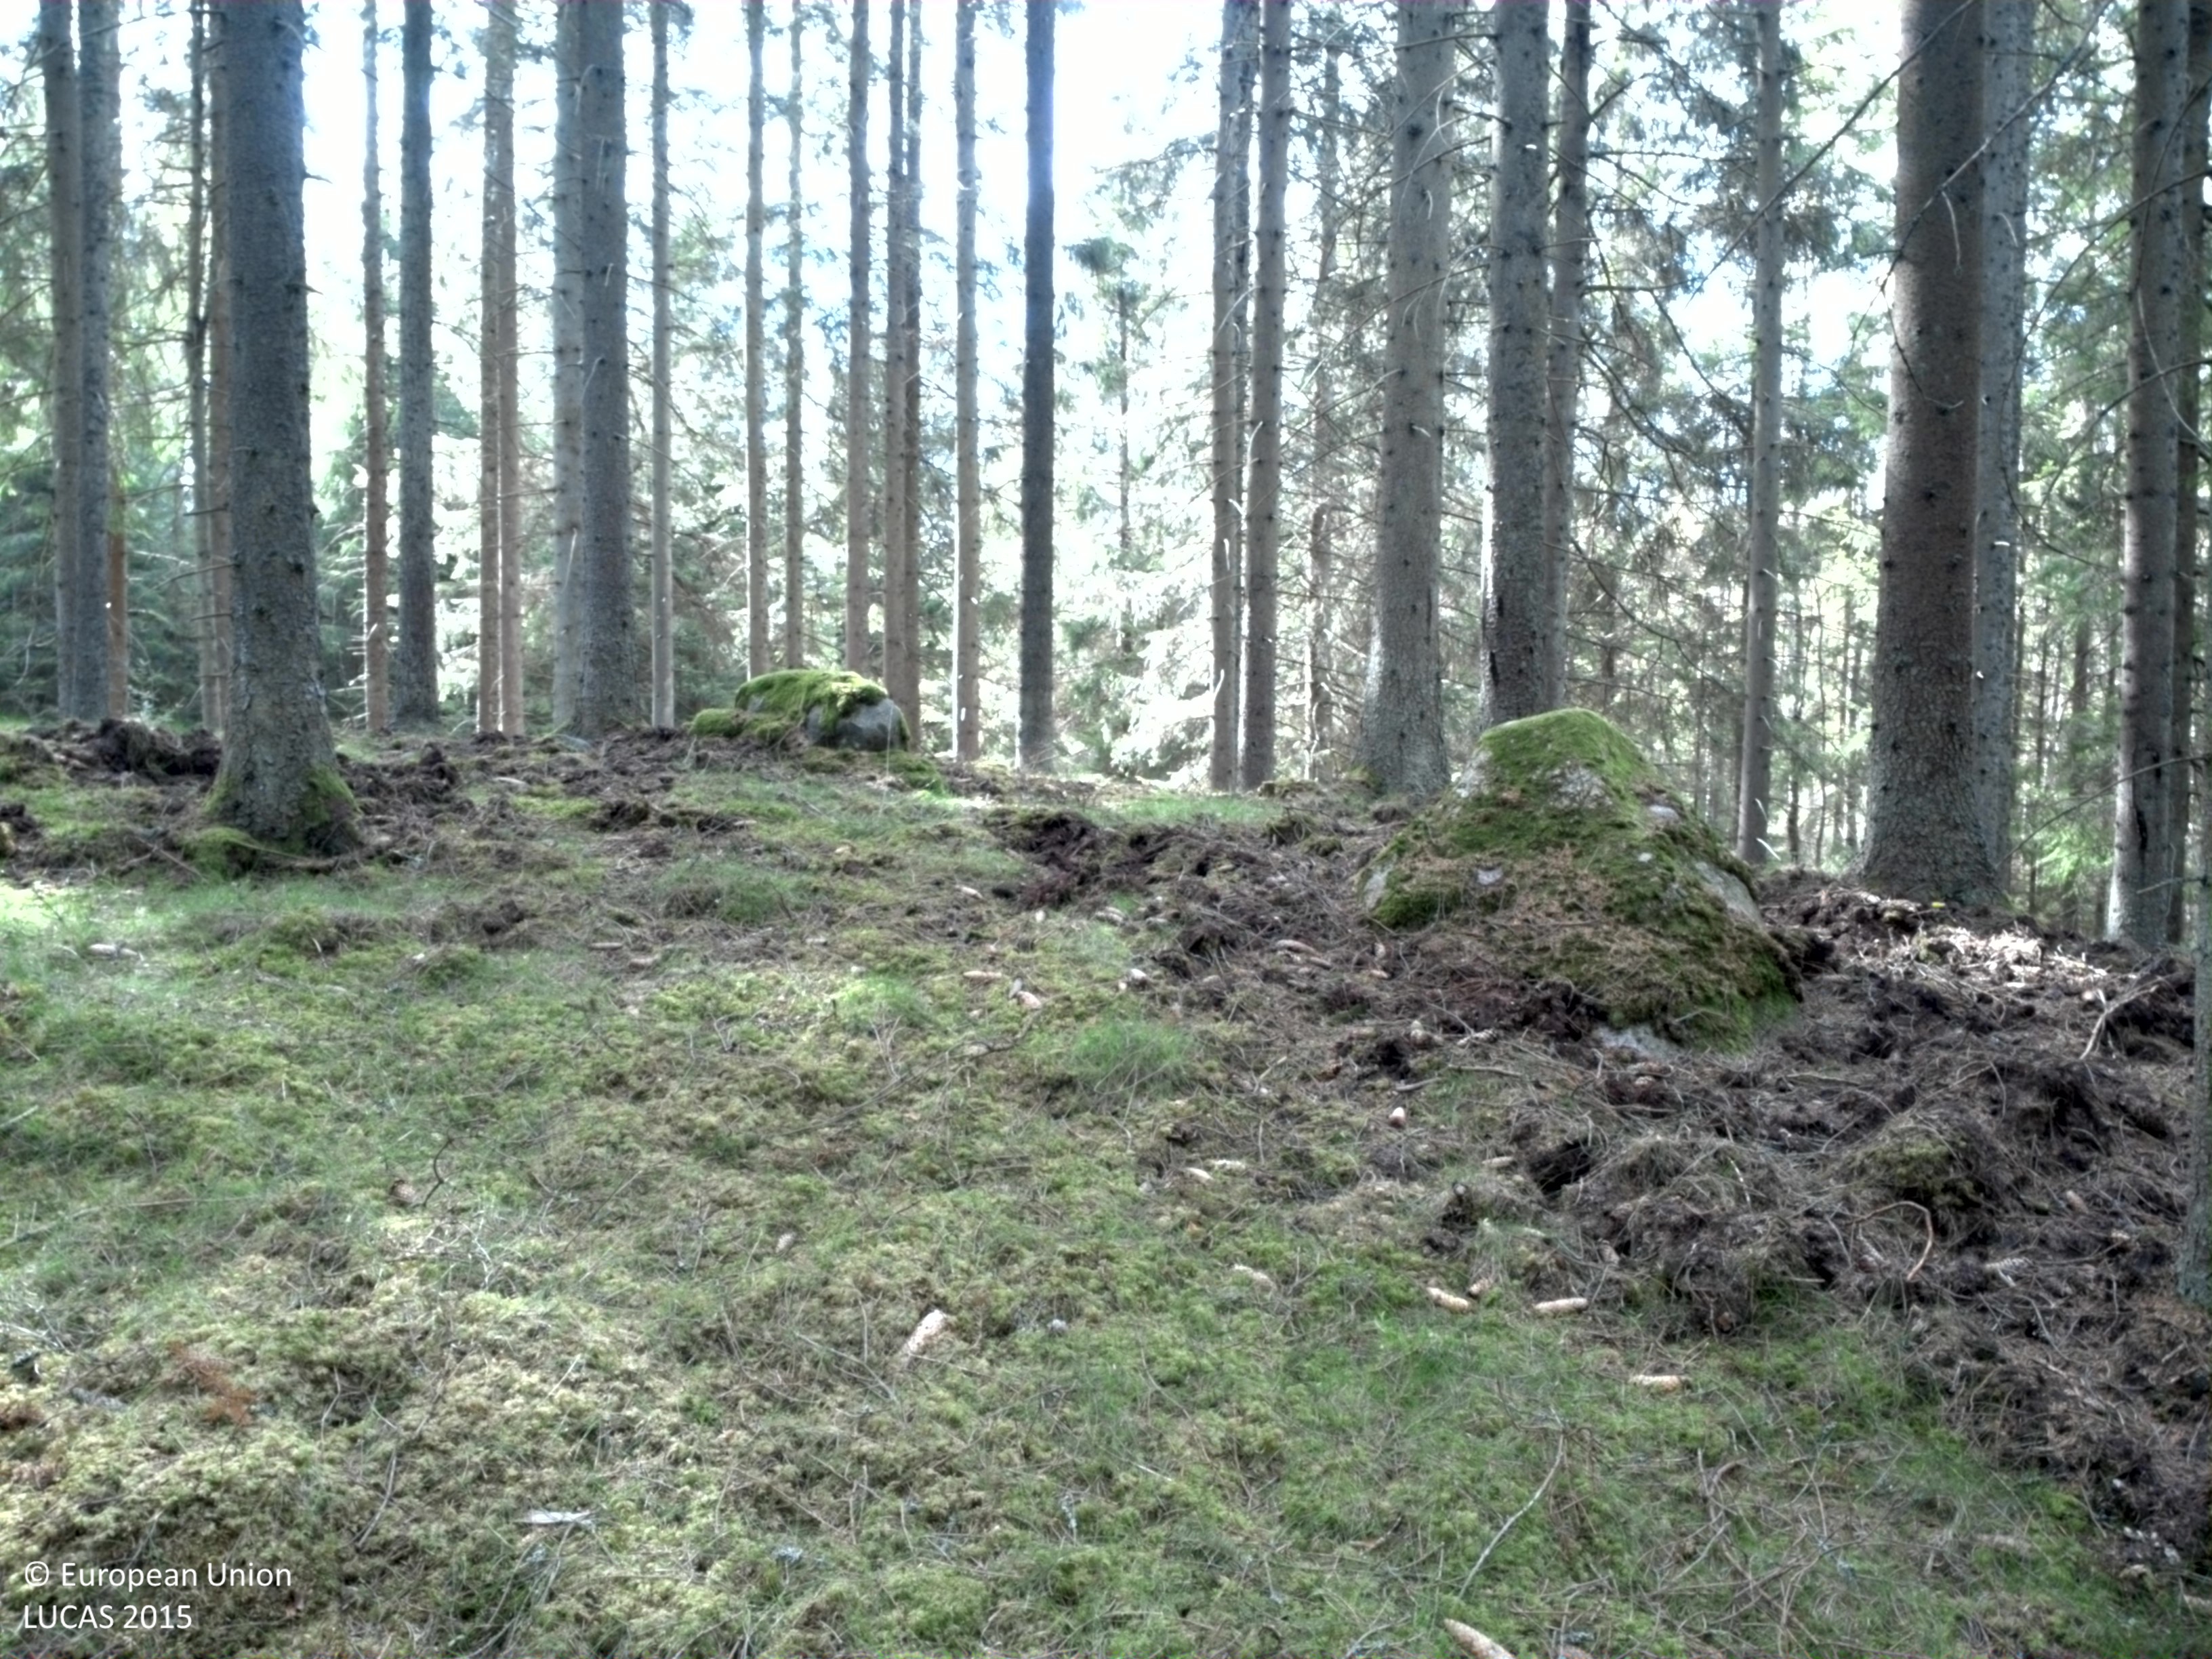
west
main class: Woodland
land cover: Spruce dominated coniferous woodland
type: boreal forest
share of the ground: > 75 %
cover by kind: coniferous forest trees 90 %, lichens and mosses 10 %
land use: Forestry
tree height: > 5 m
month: May
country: SE
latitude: 56.4343
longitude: 15.8219
